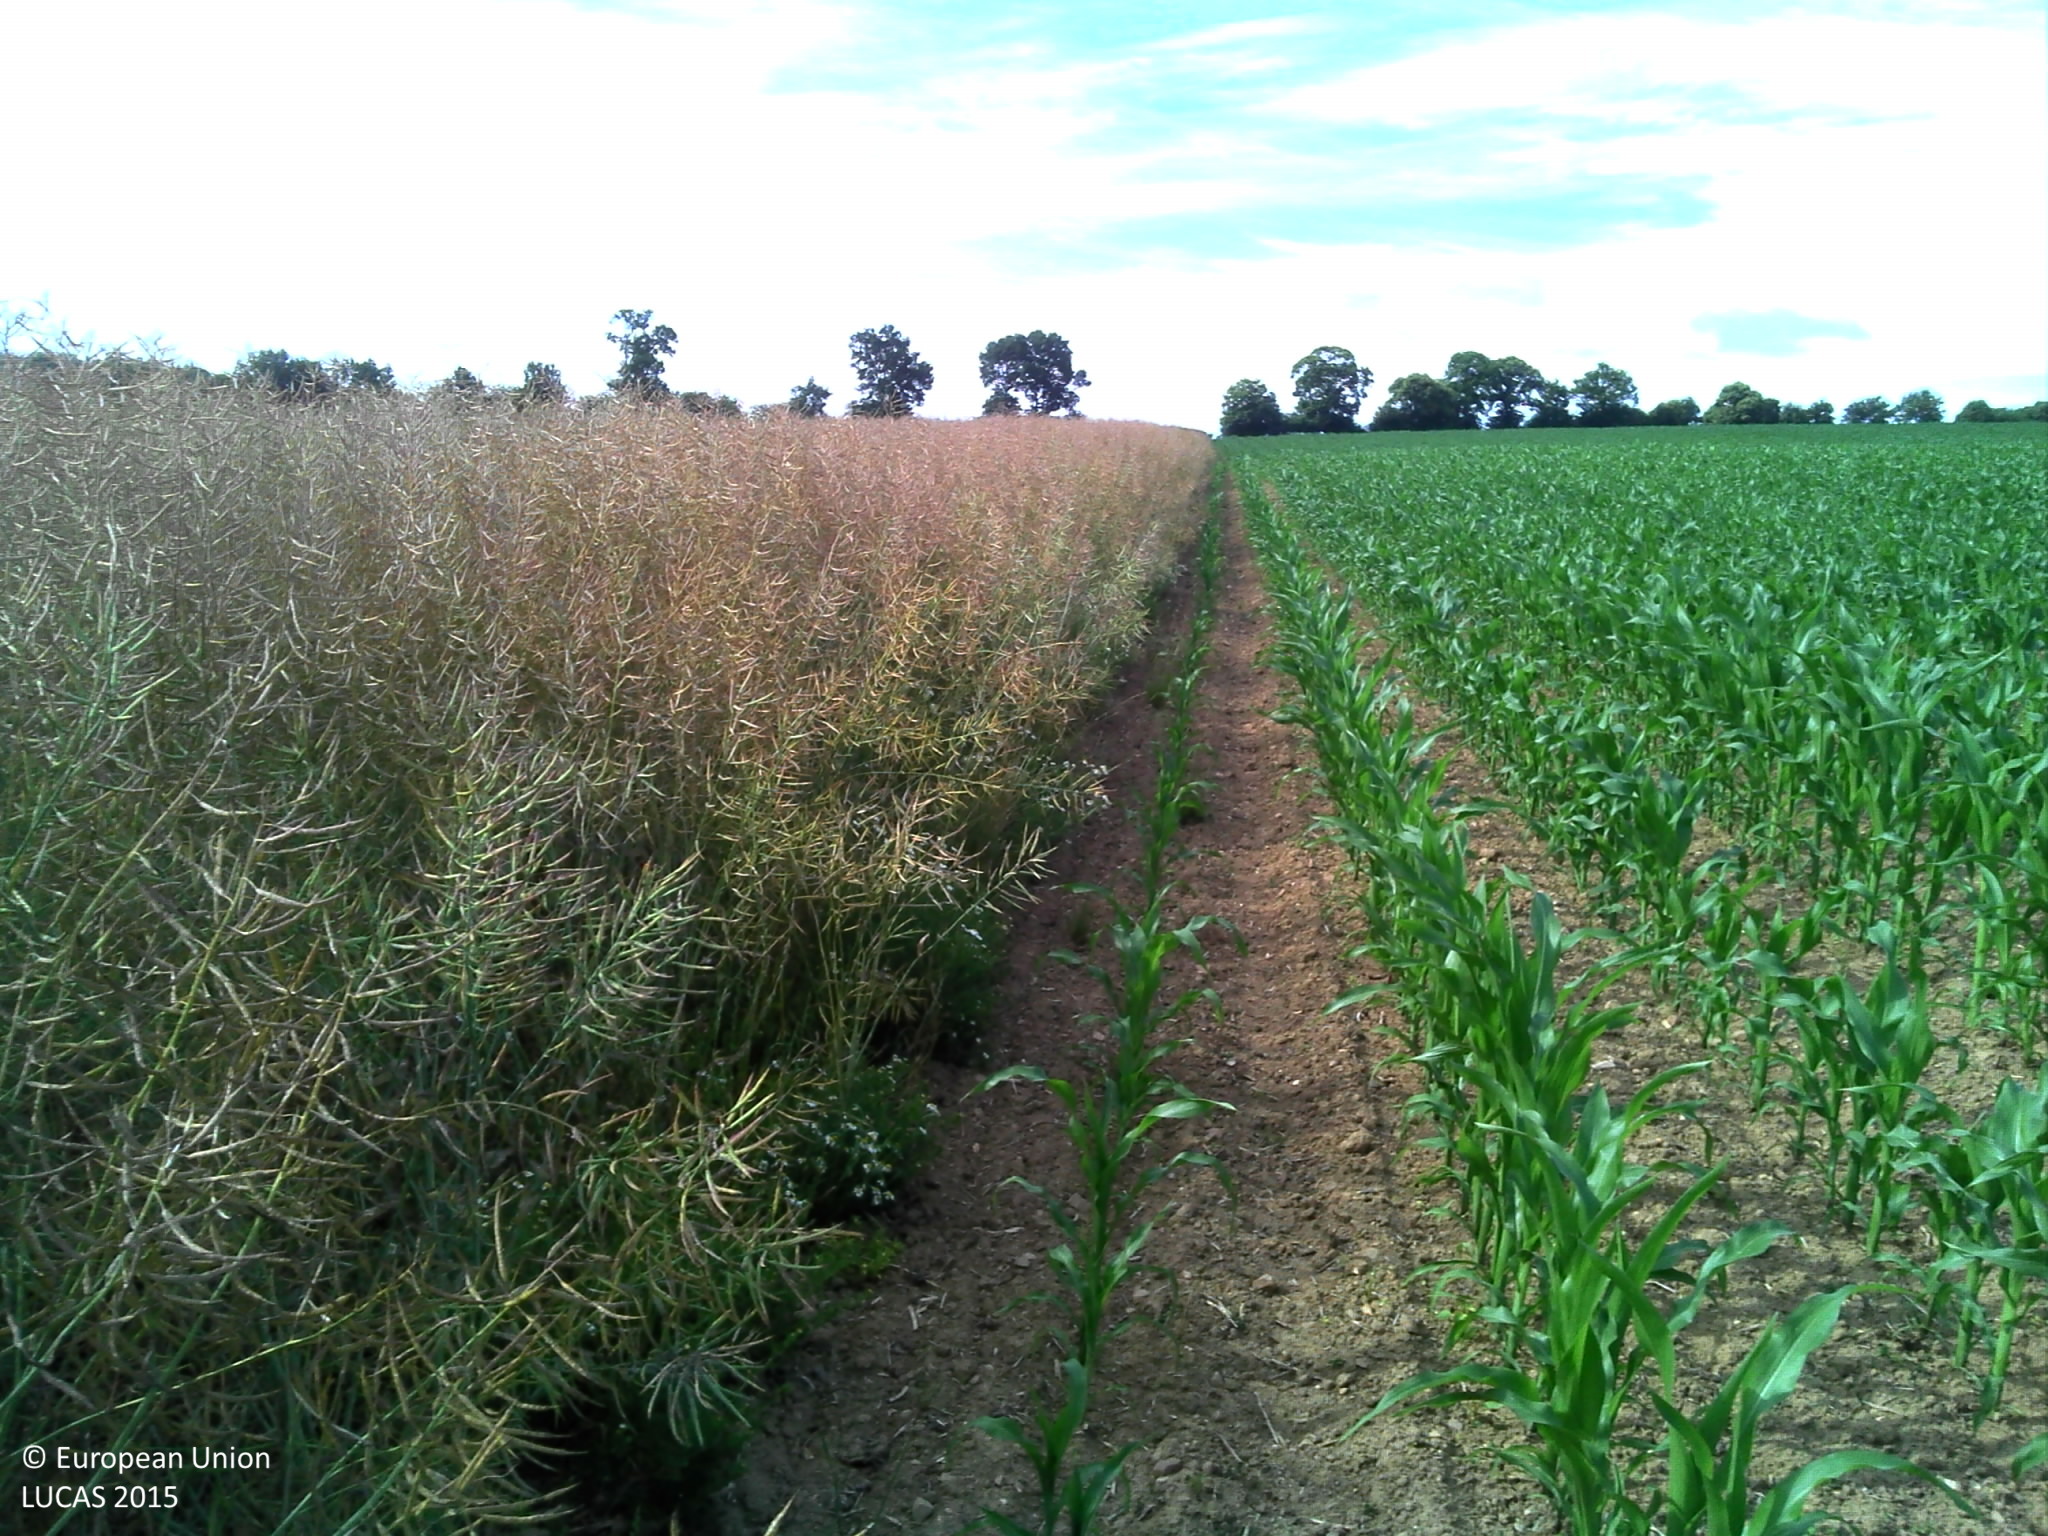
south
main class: Cropland
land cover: Rape and turnip rape
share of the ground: > 75 %
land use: Agriculture (excluding fallow land and kitchen gardens)
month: June
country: FR
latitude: 47.8830
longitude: -1.5862
